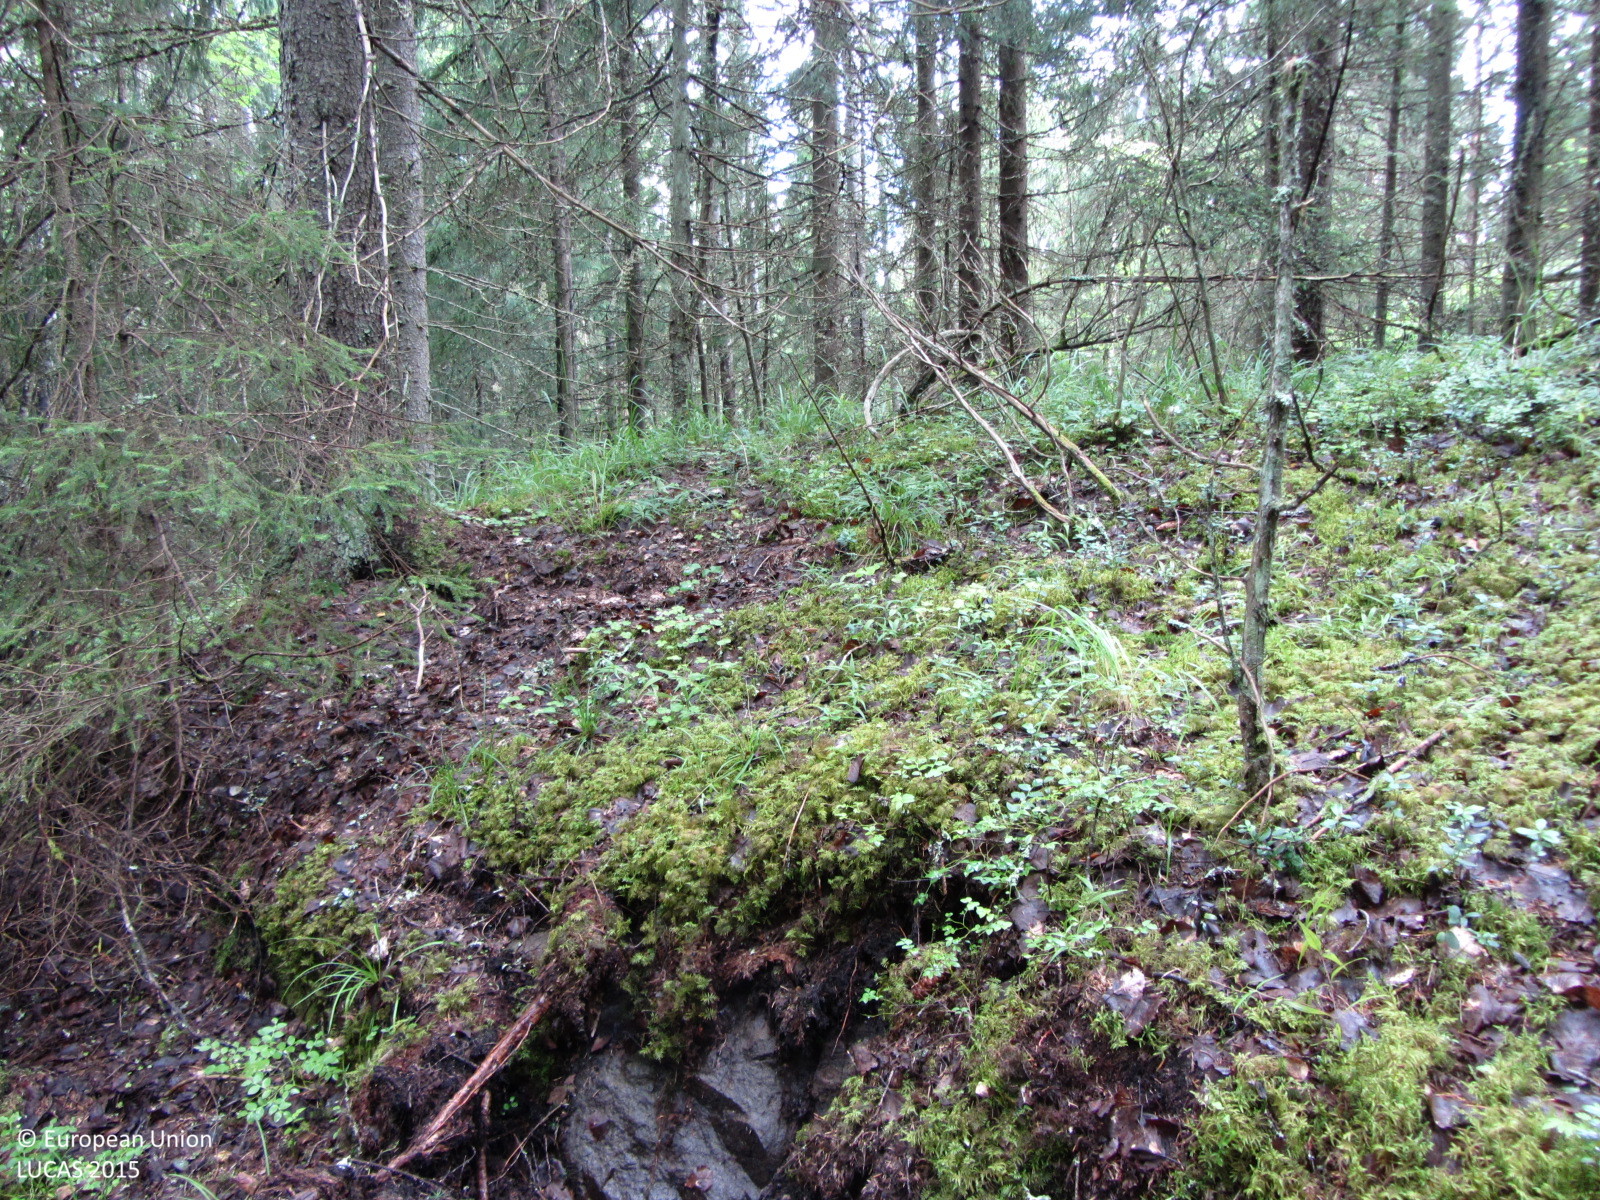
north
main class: Woodland
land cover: Spruce dominated mixed woodland
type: boreal forest
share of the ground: > 75 %
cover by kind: coniferous forest trees 60 %, broadleaved forest trees 20 %, lichens and mosses 10 %, shrubs 5 %, herbaceous plants 5 %
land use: Forestry
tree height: > 5 m
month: July
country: FI
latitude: 60.4870
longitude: 24.3525
